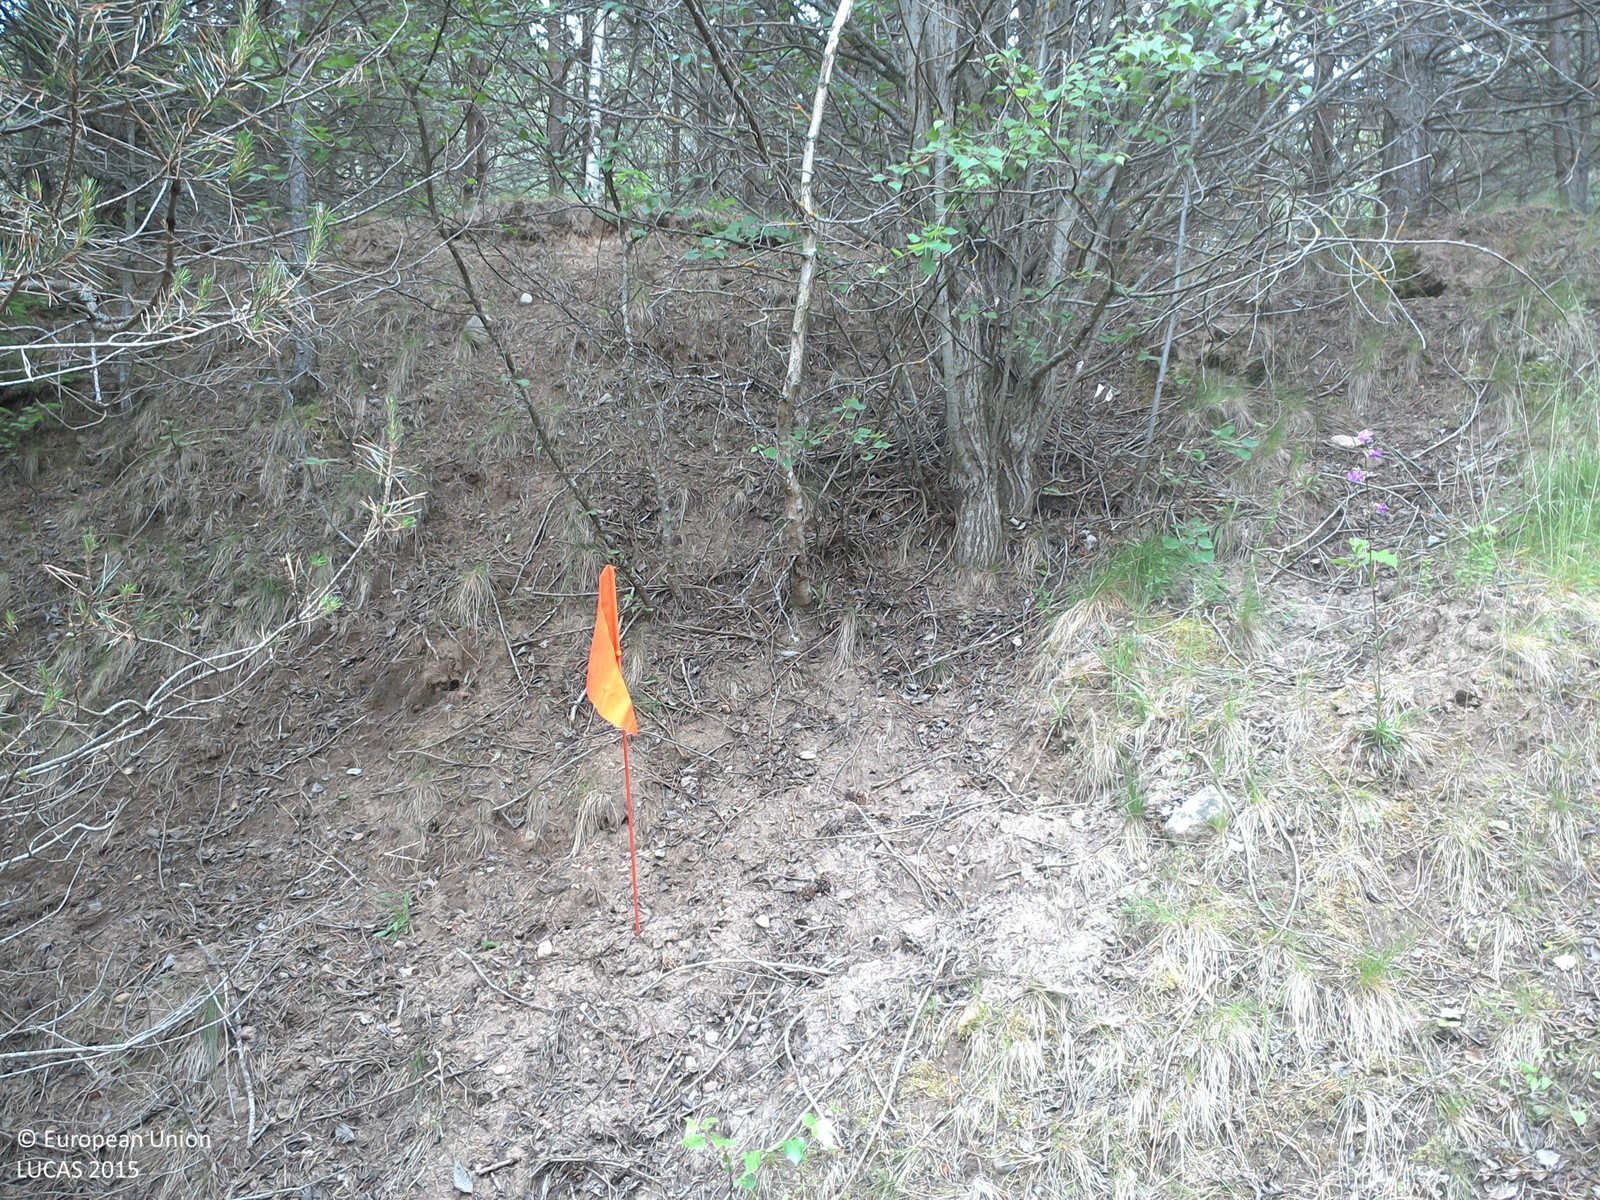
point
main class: Woodland
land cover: Pine dominated coniferous woodland
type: boreal forest
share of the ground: > 75 %
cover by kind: coniferous forest trees 85 %, unconsolidated bare surface 15 %
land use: Forestry
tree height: > 5 m
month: June
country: SE
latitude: 58.3754
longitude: 15.5517
